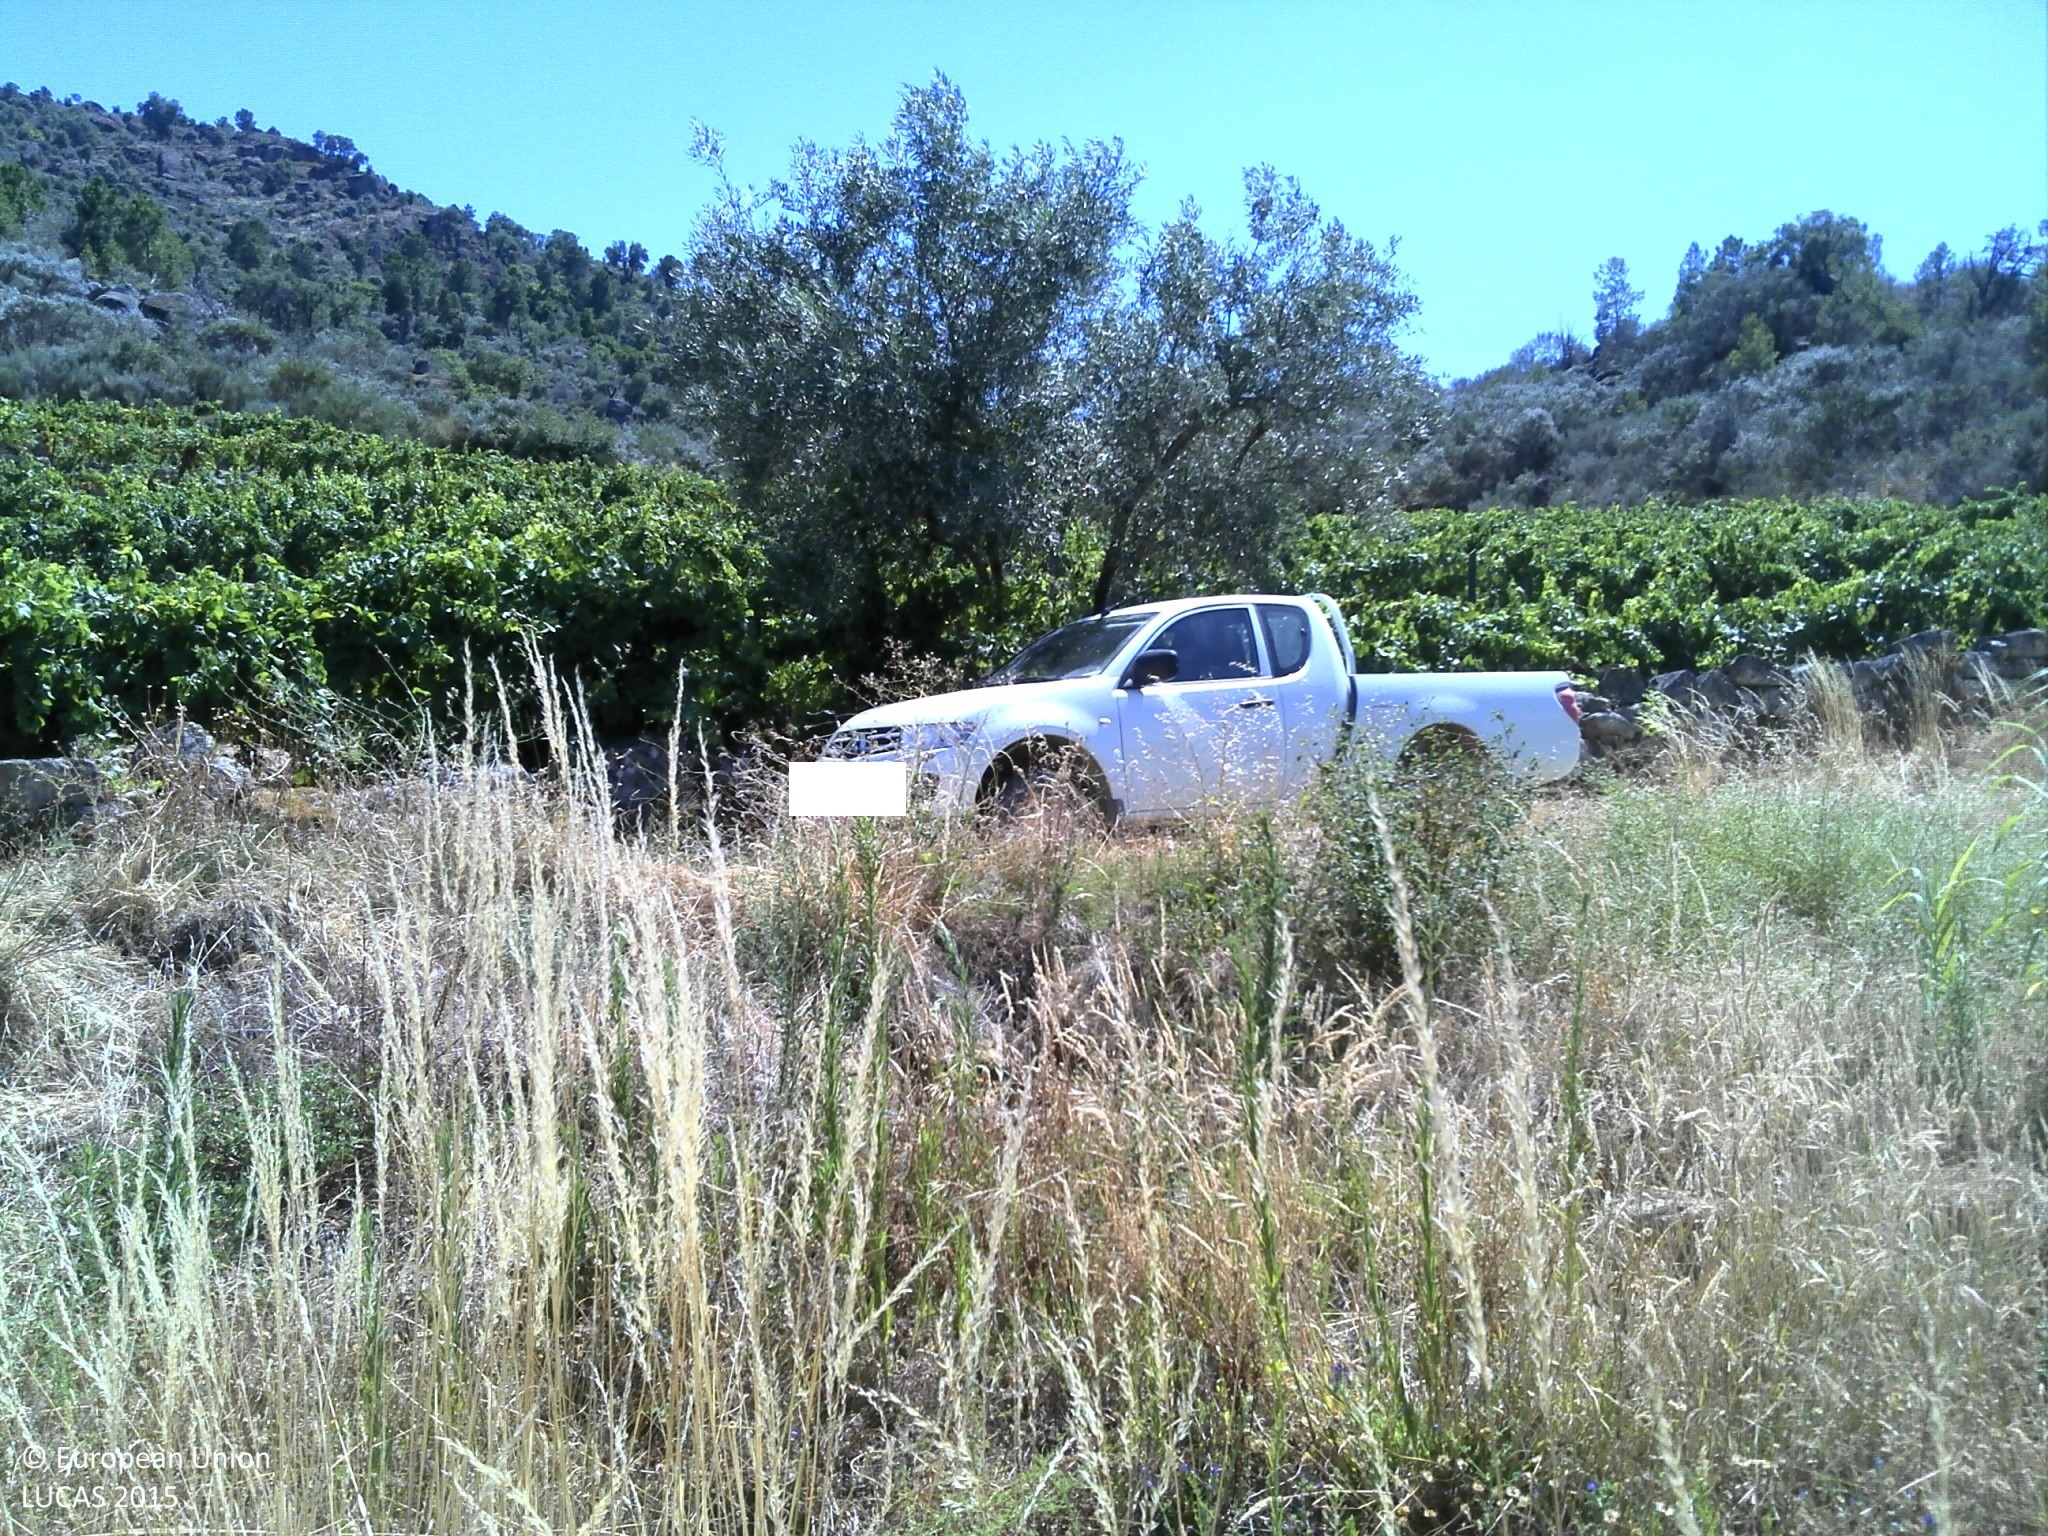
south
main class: Grassland
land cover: Grassland without tree/shrub cover
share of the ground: > 75 %
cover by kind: herbaceous plants 100 %
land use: Agriculture (excluding fallow land and kitchen gardens)
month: July
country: PT
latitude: 41.3121
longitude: -7.3327
